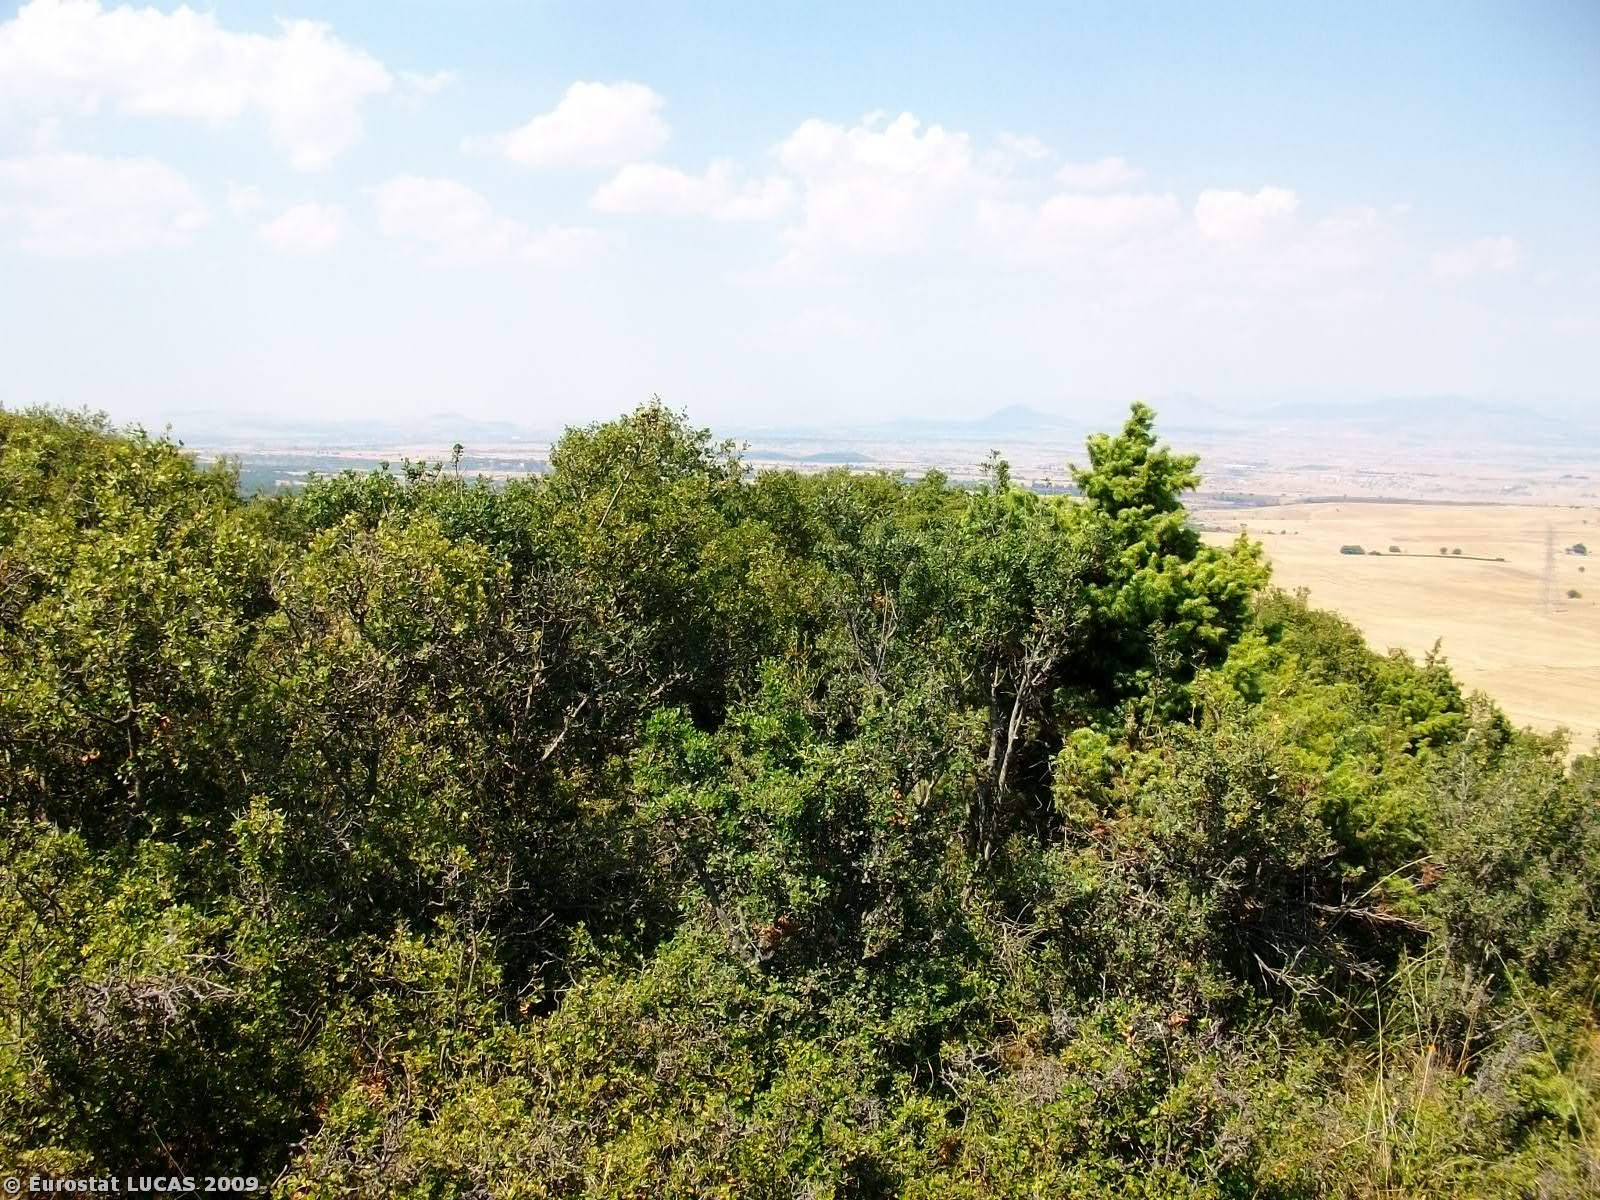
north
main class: Shrubland
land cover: Shrubland without tree cover
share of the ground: > 75 %
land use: Unused
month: July
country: GR
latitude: 40.1566
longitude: 21.7891
